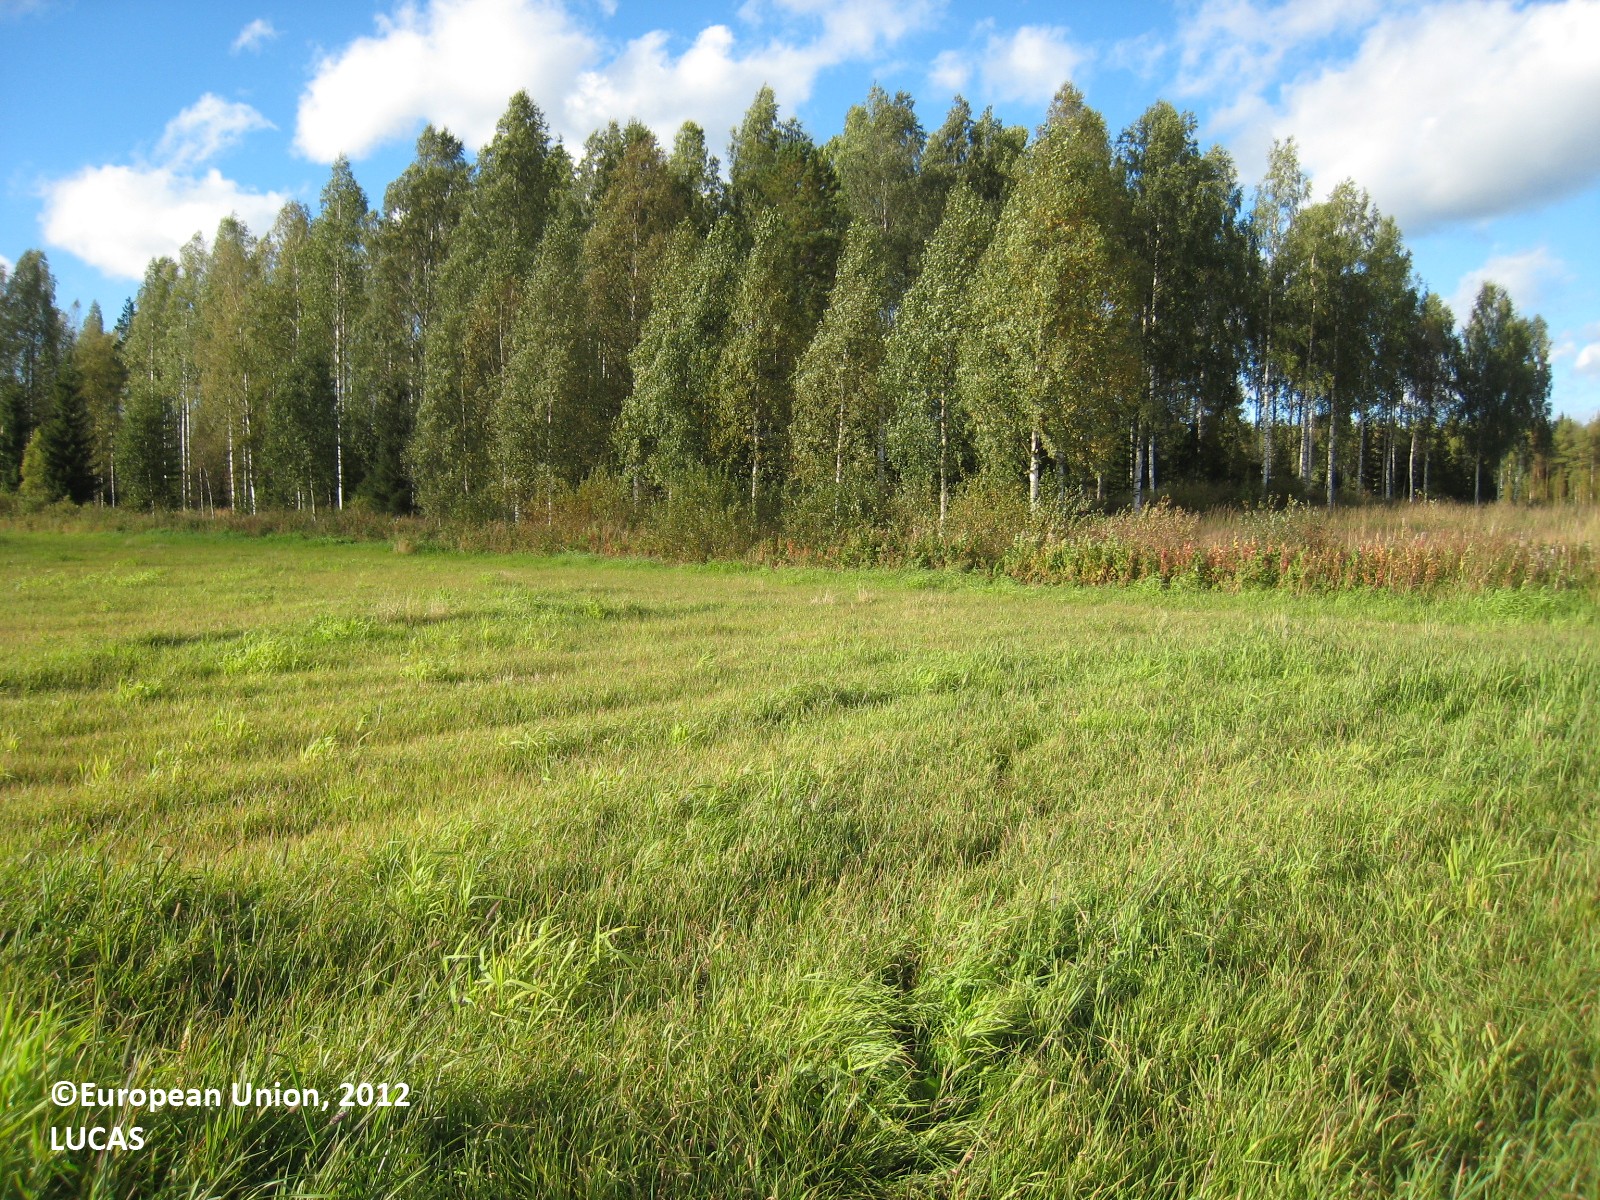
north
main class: Cropland
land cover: Temporary grasslands
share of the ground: > 75 %
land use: Agriculture (excluding fallow land and kitchen gardens)
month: September
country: FI
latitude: 63.1113
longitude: 26.8891
